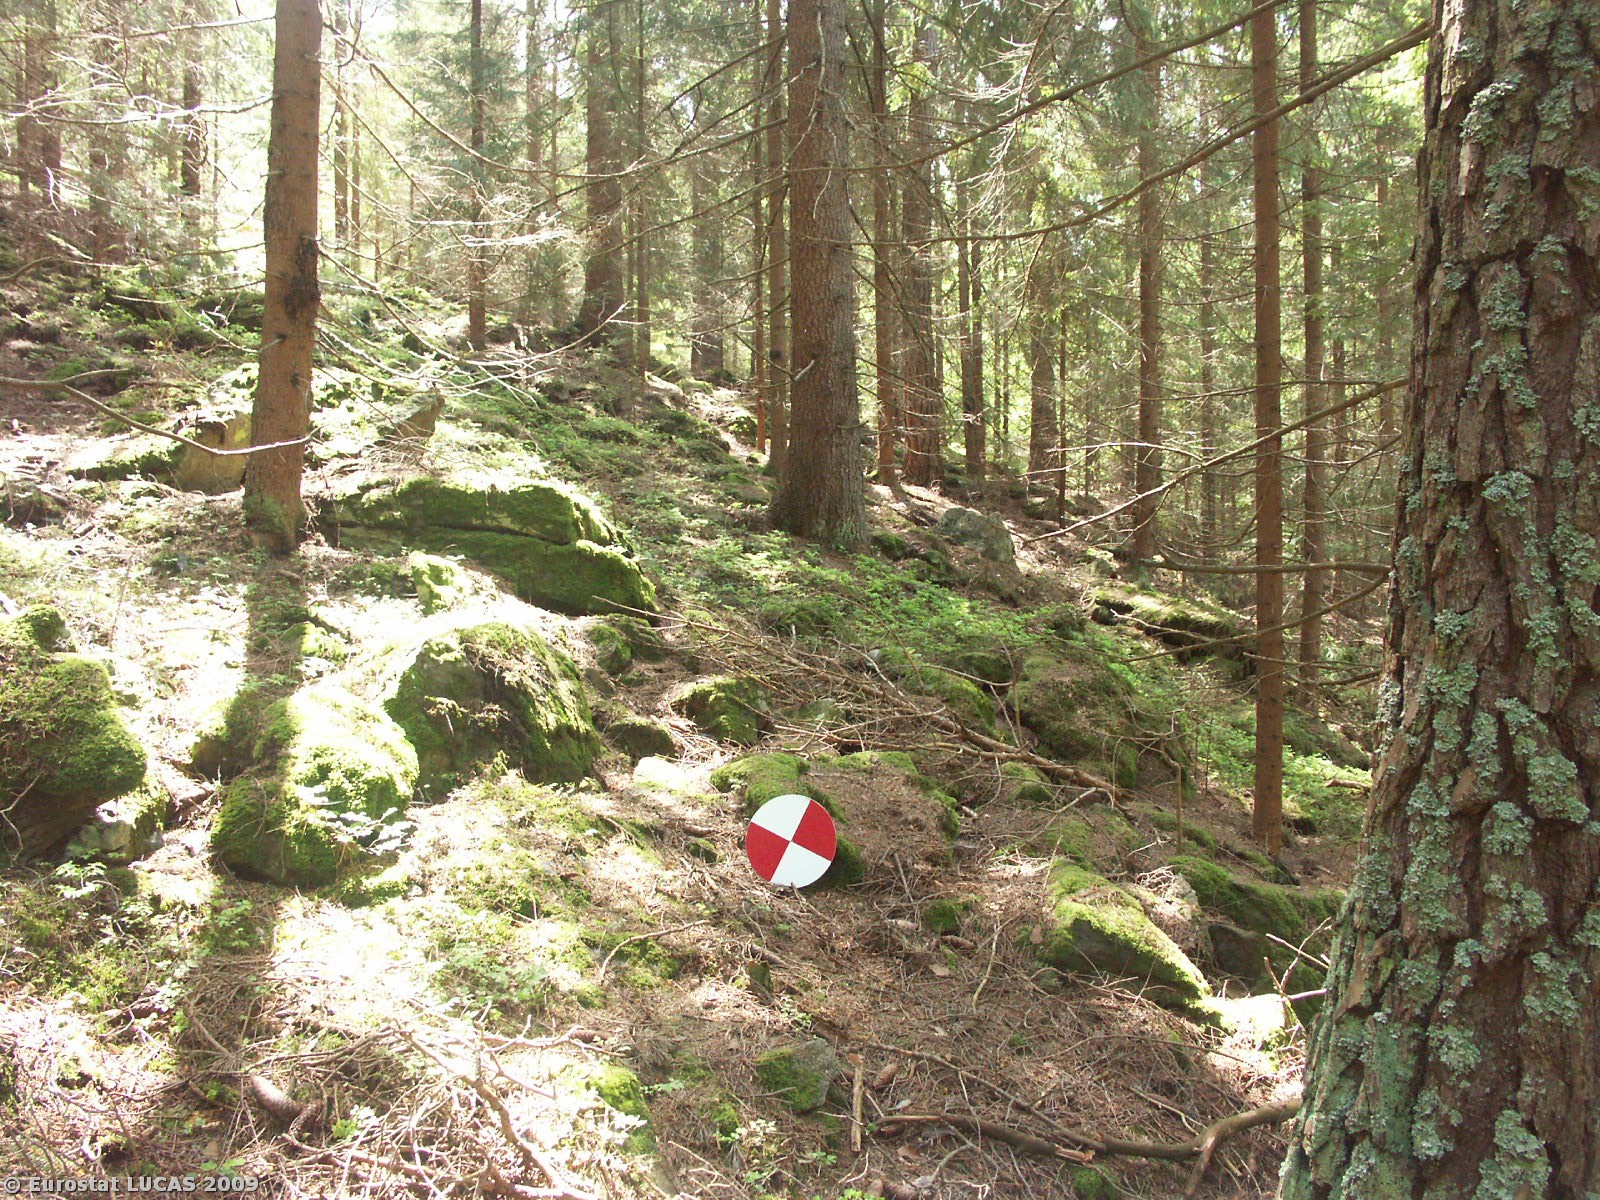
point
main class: Woodland
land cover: Coniferous woodland
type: hemiboreal forest and nemoral coniferous forest and mixed broadleaved-coniferous forest
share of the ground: > 75 %
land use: Forestry
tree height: > 5 m
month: May
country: CZ
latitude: 48.7028
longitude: 14.6346
